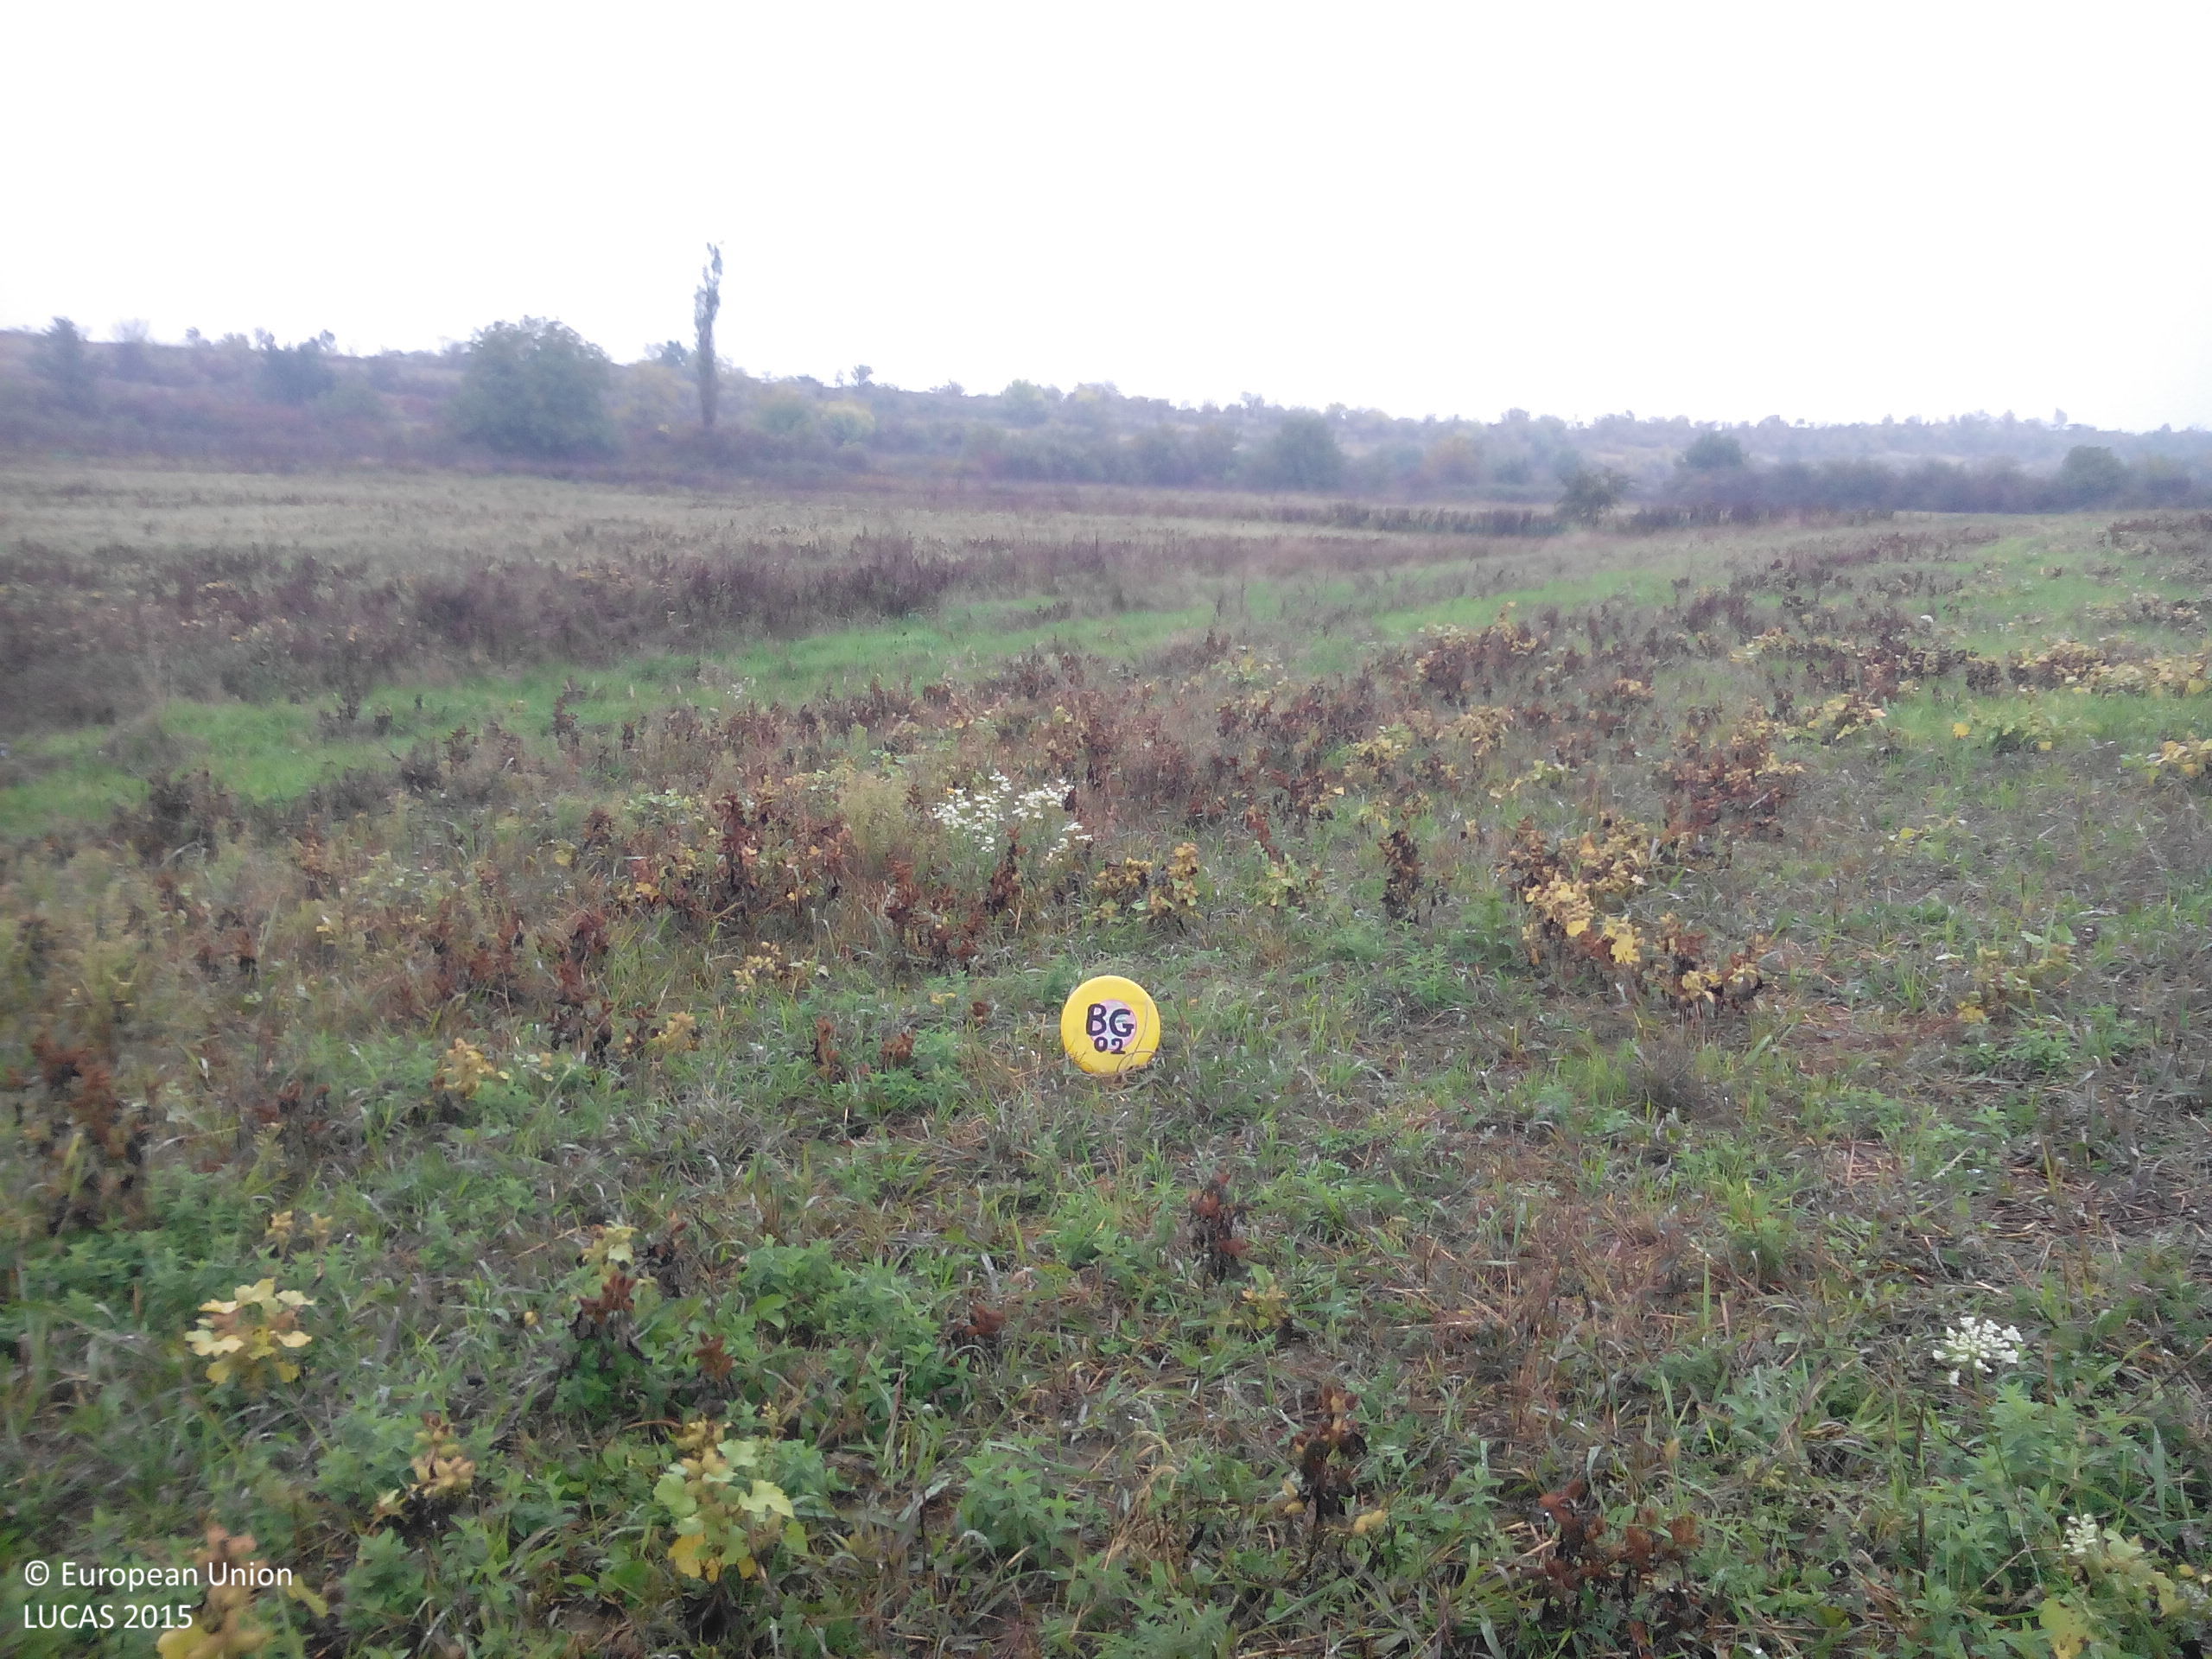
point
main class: Grassland
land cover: Grassland without tree/shrub cover
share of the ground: > 75 %
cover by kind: herbaceous plants 95 %, shrubs 5 %
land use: Agriculture (excluding fallow land and kitchen gardens)
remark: Harvested field
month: October
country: BG
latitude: 43.1724
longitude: 24.1617
